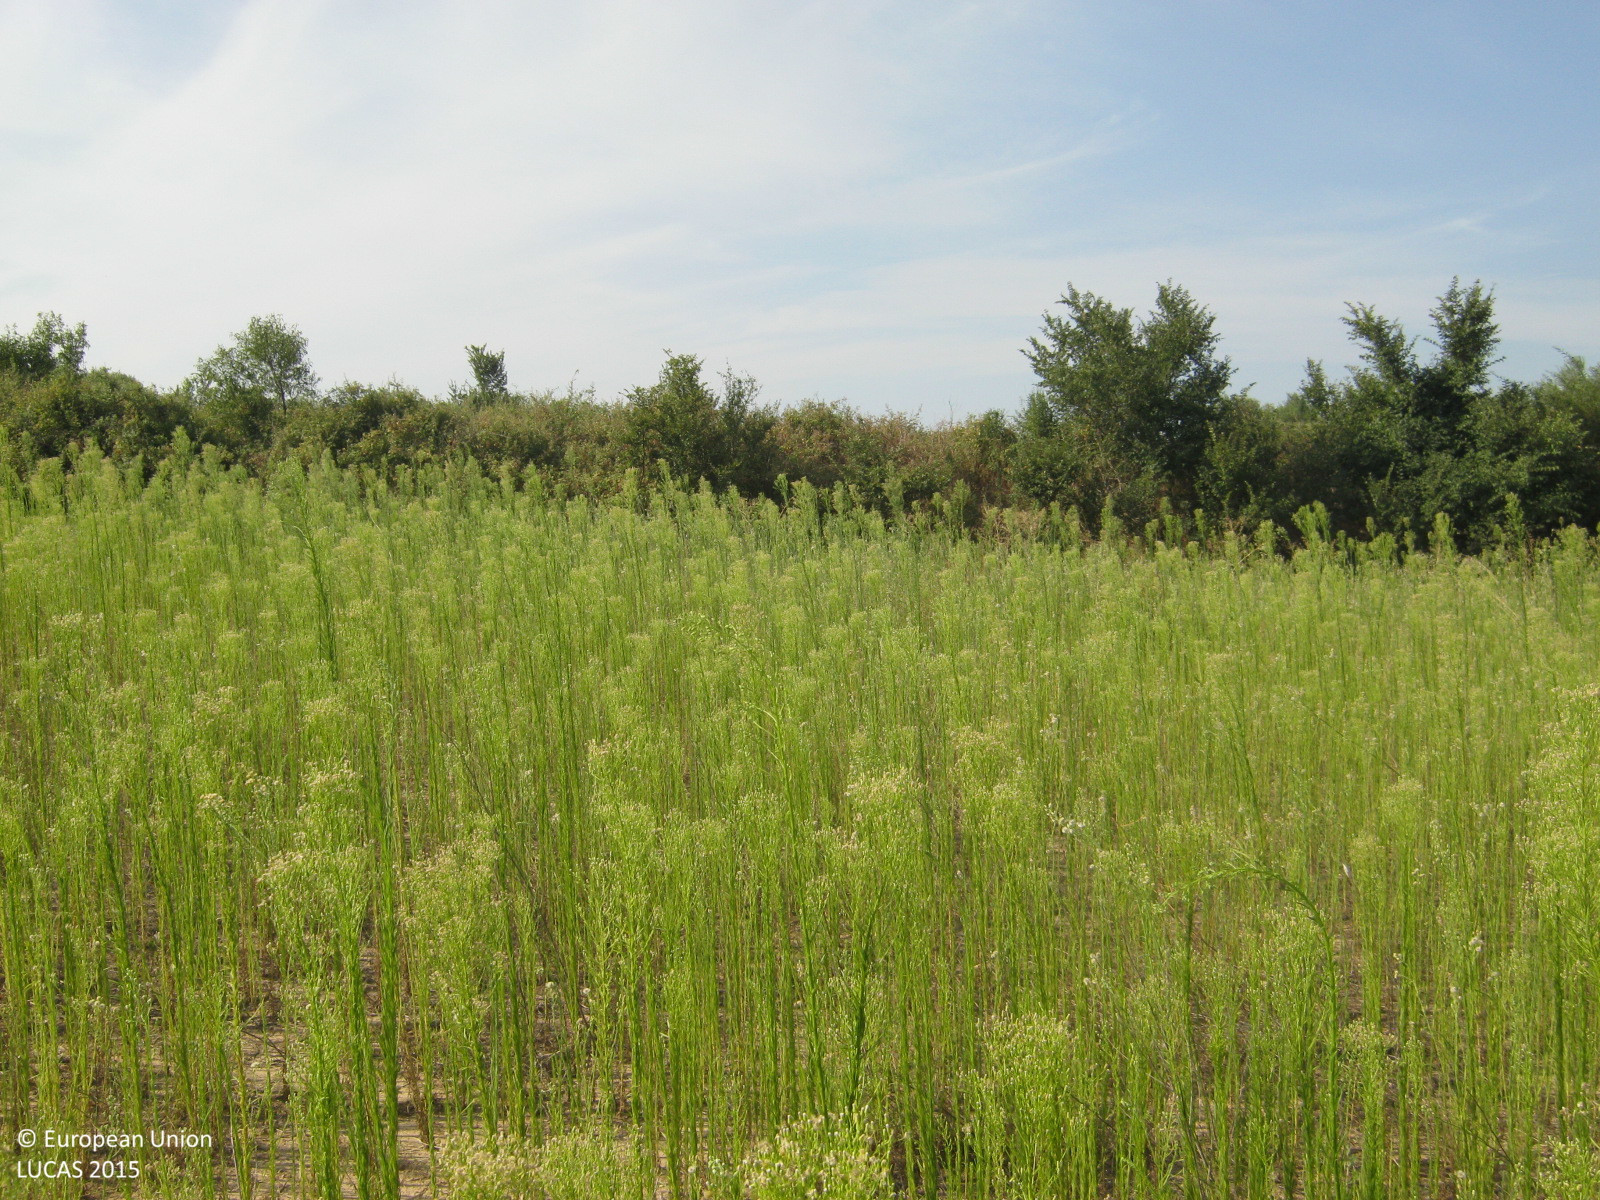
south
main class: Grassland
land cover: Spontaneously vegetated surfaces
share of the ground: > 75 %
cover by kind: herbaceous plants 90 %, unconsolidated bare surface 10 %
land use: Fallow land
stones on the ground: < 10 %
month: August
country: GR
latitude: 40.9295
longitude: 23.4484
